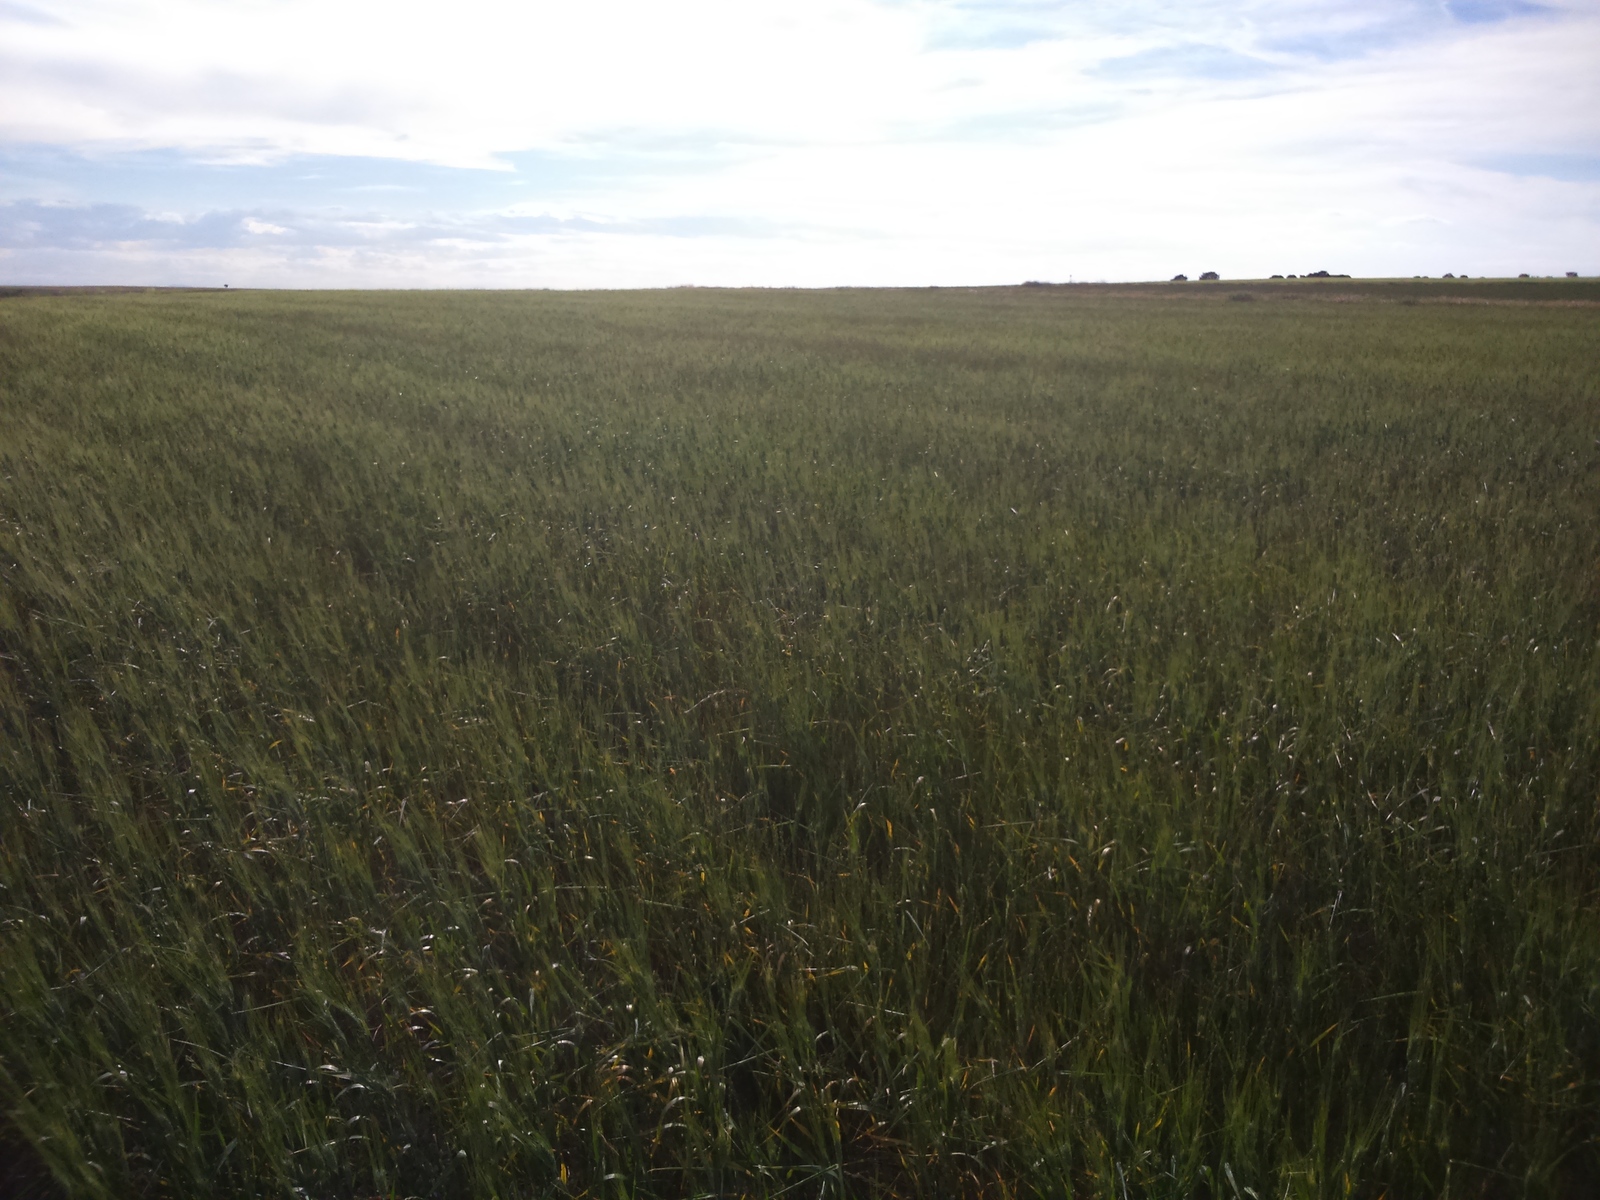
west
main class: Cropland
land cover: Durum wheat
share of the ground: > 75 %
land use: Agriculture (excluding fallow land and kitchen gardens)
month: April
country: ES
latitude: 41.4592
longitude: -0.2517
